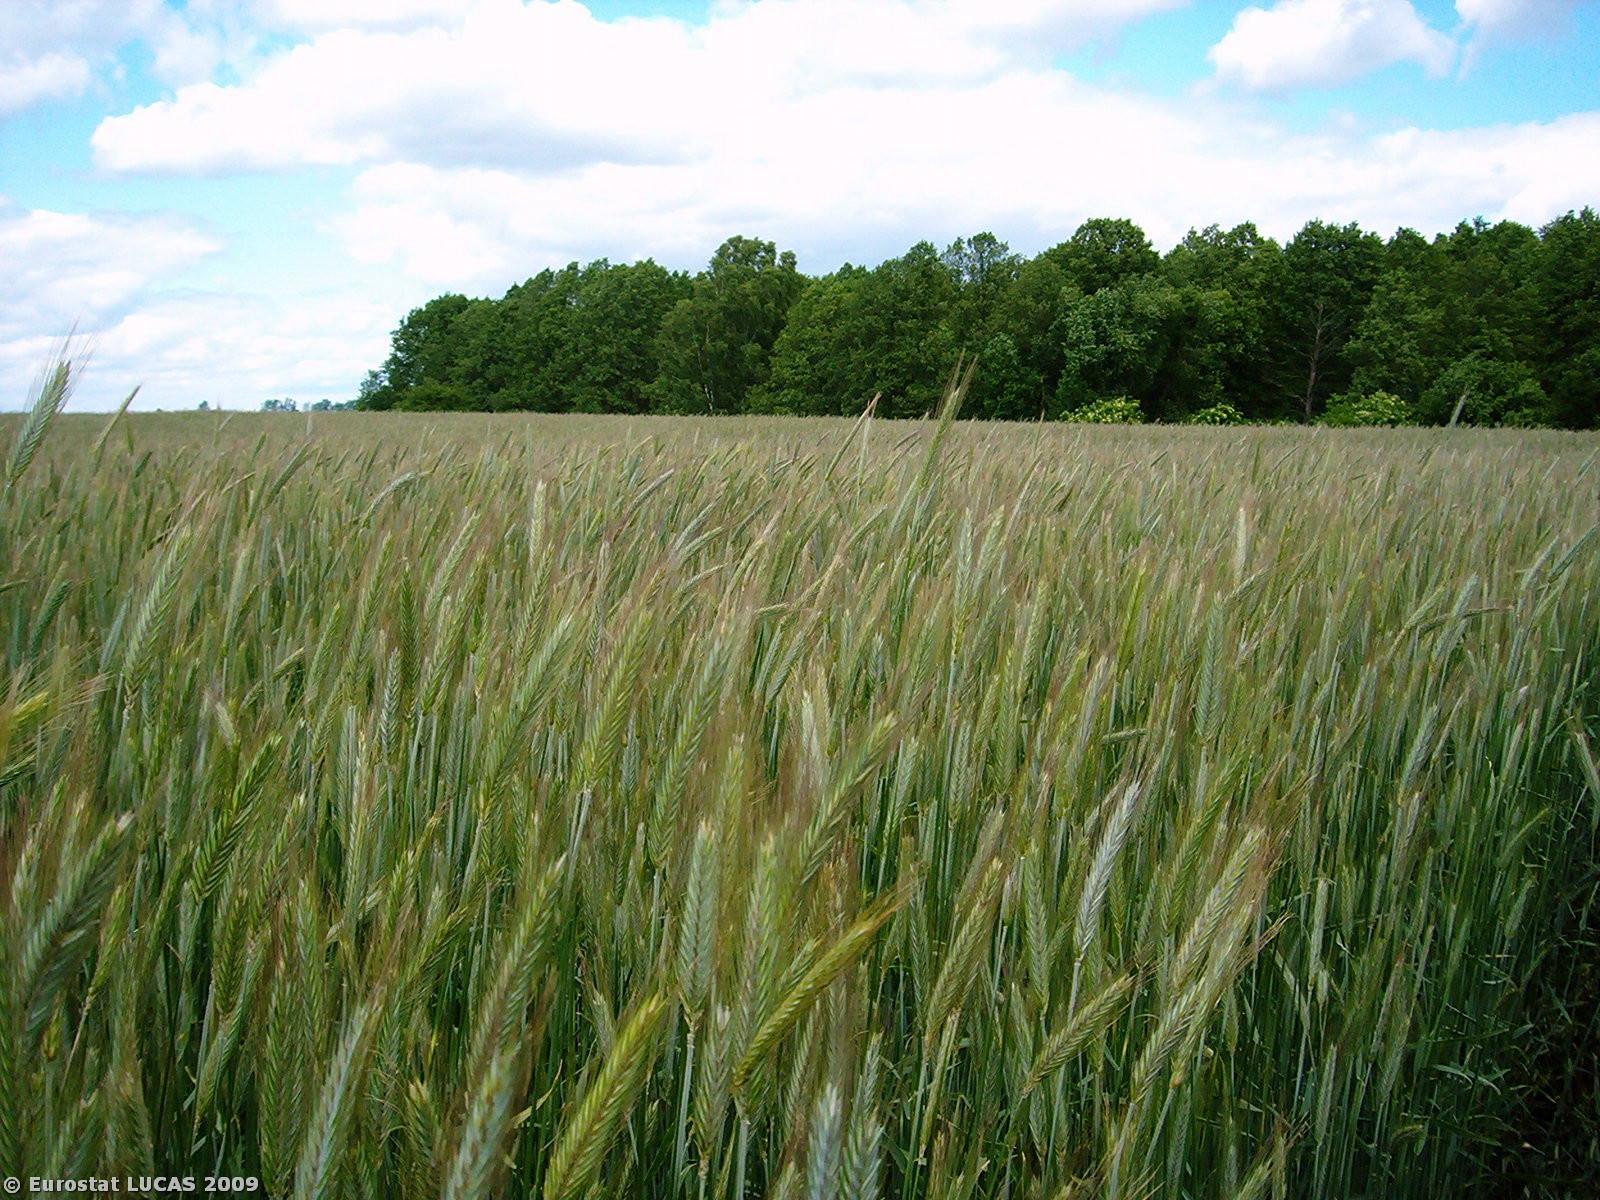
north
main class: Cropland
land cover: Rye
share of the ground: > 75 %
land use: Agriculture (excluding fallow land and kitchen gardens)
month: June
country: PL
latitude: 53.5873
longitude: 17.1551
